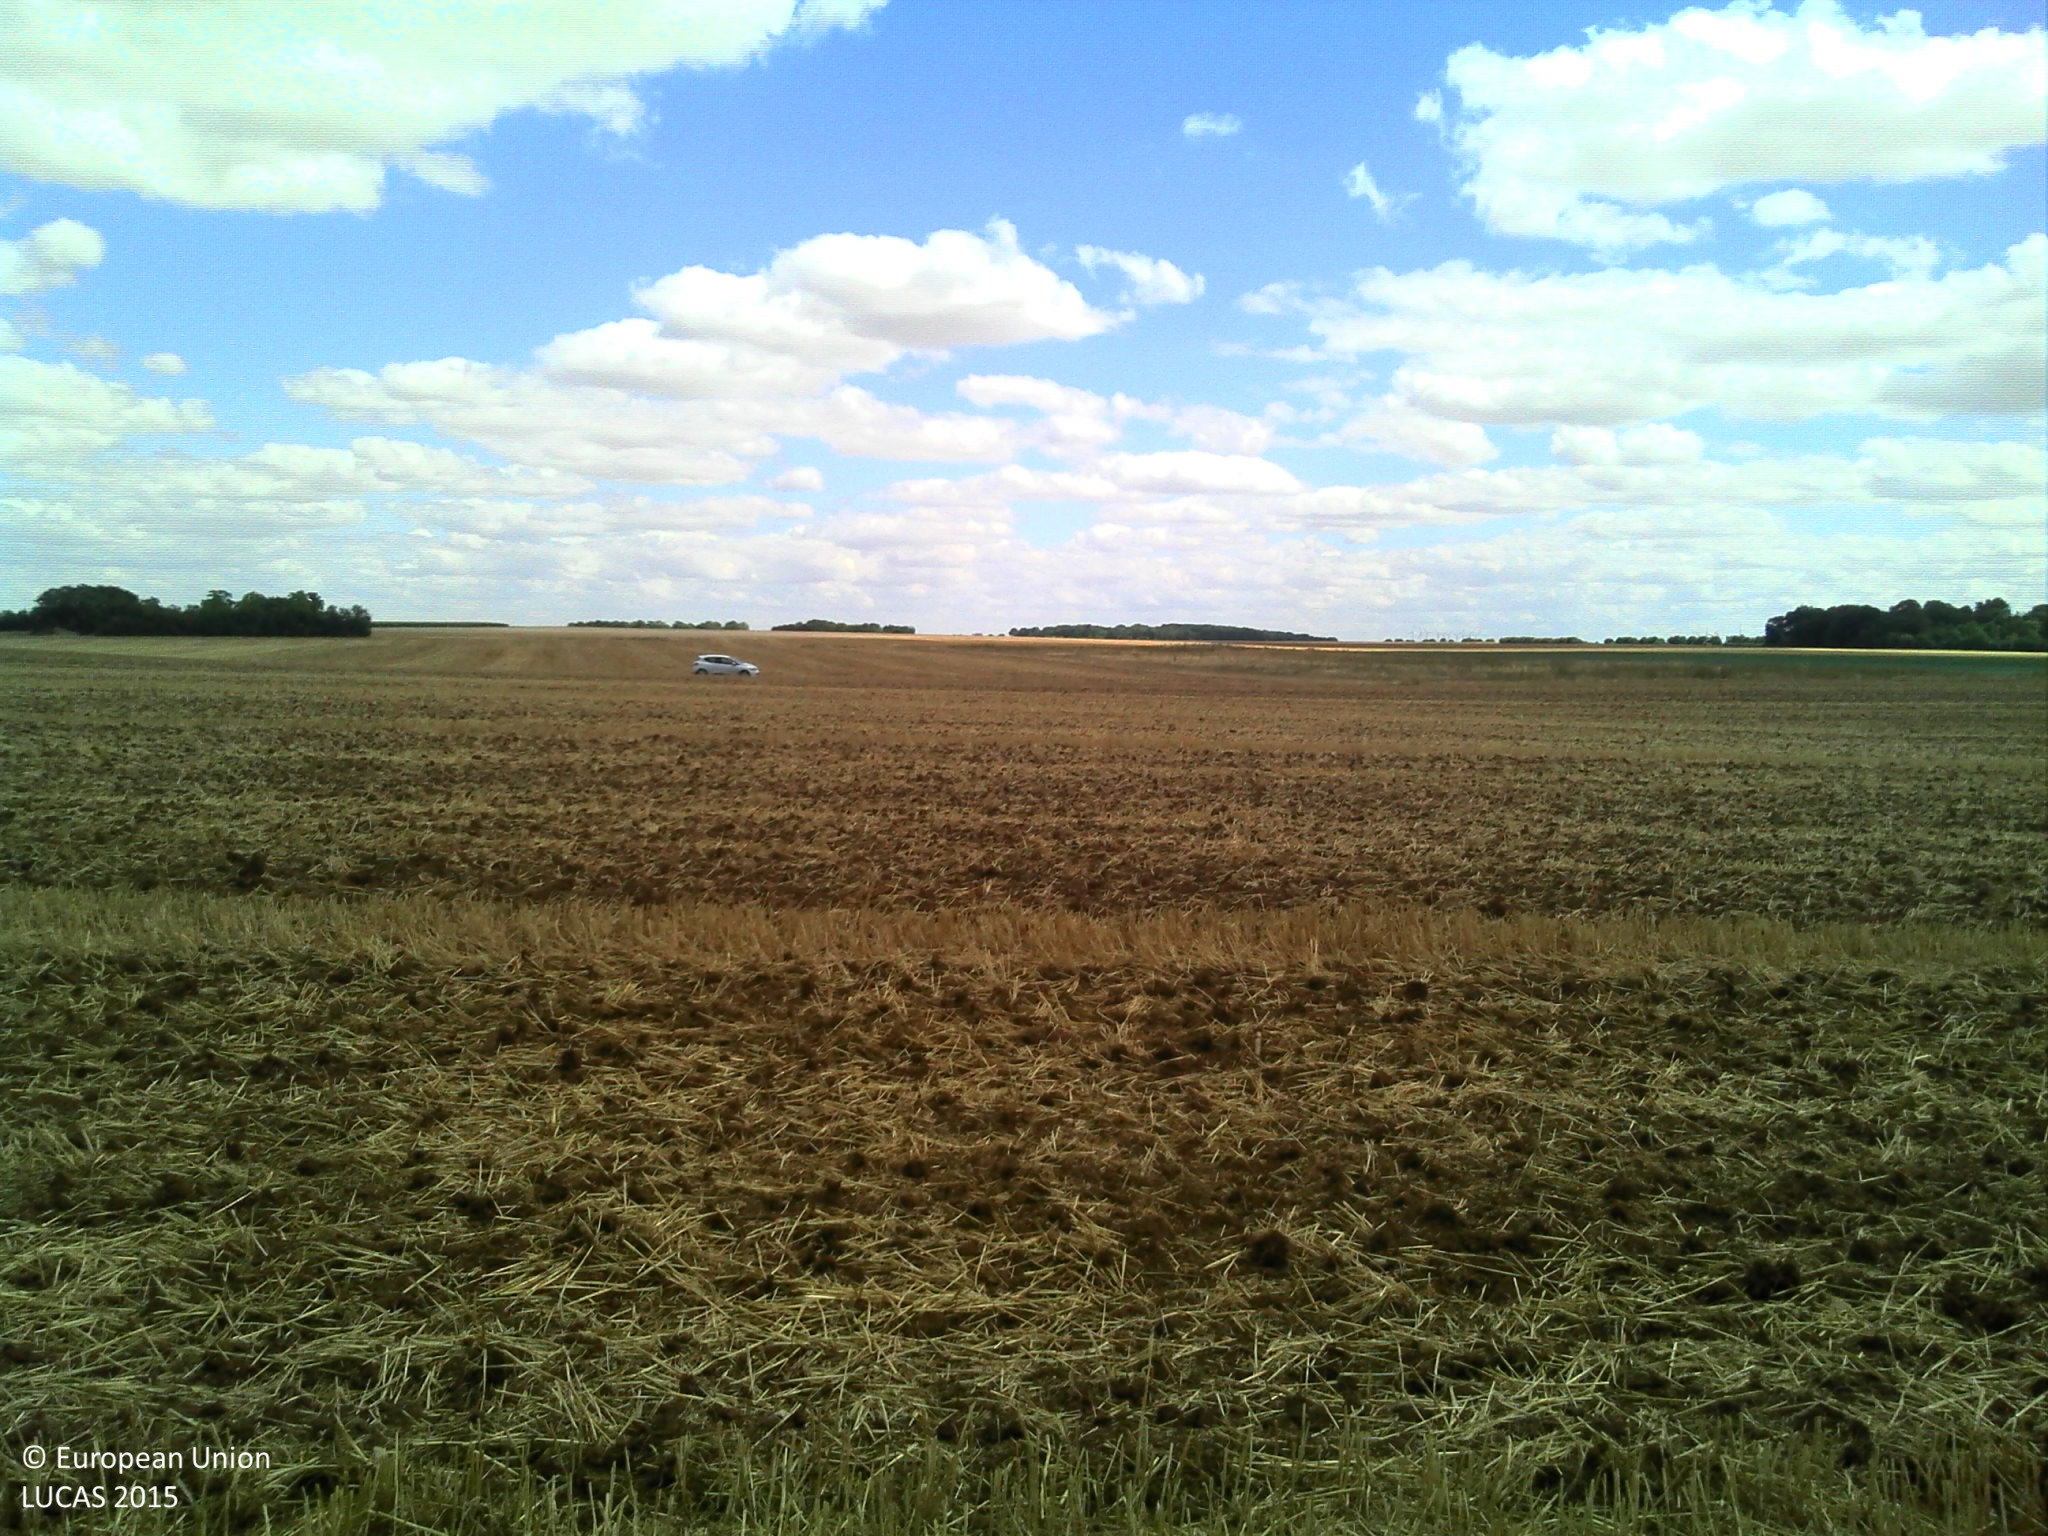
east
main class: Cropland
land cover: Common wheat
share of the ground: > 75 %
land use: Agriculture (excluding fallow land and kitchen gardens)
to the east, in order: Common wheat; Grass margins; Tracks; Common wheat
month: August
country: FR
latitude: 48.2579
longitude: 1.9995
